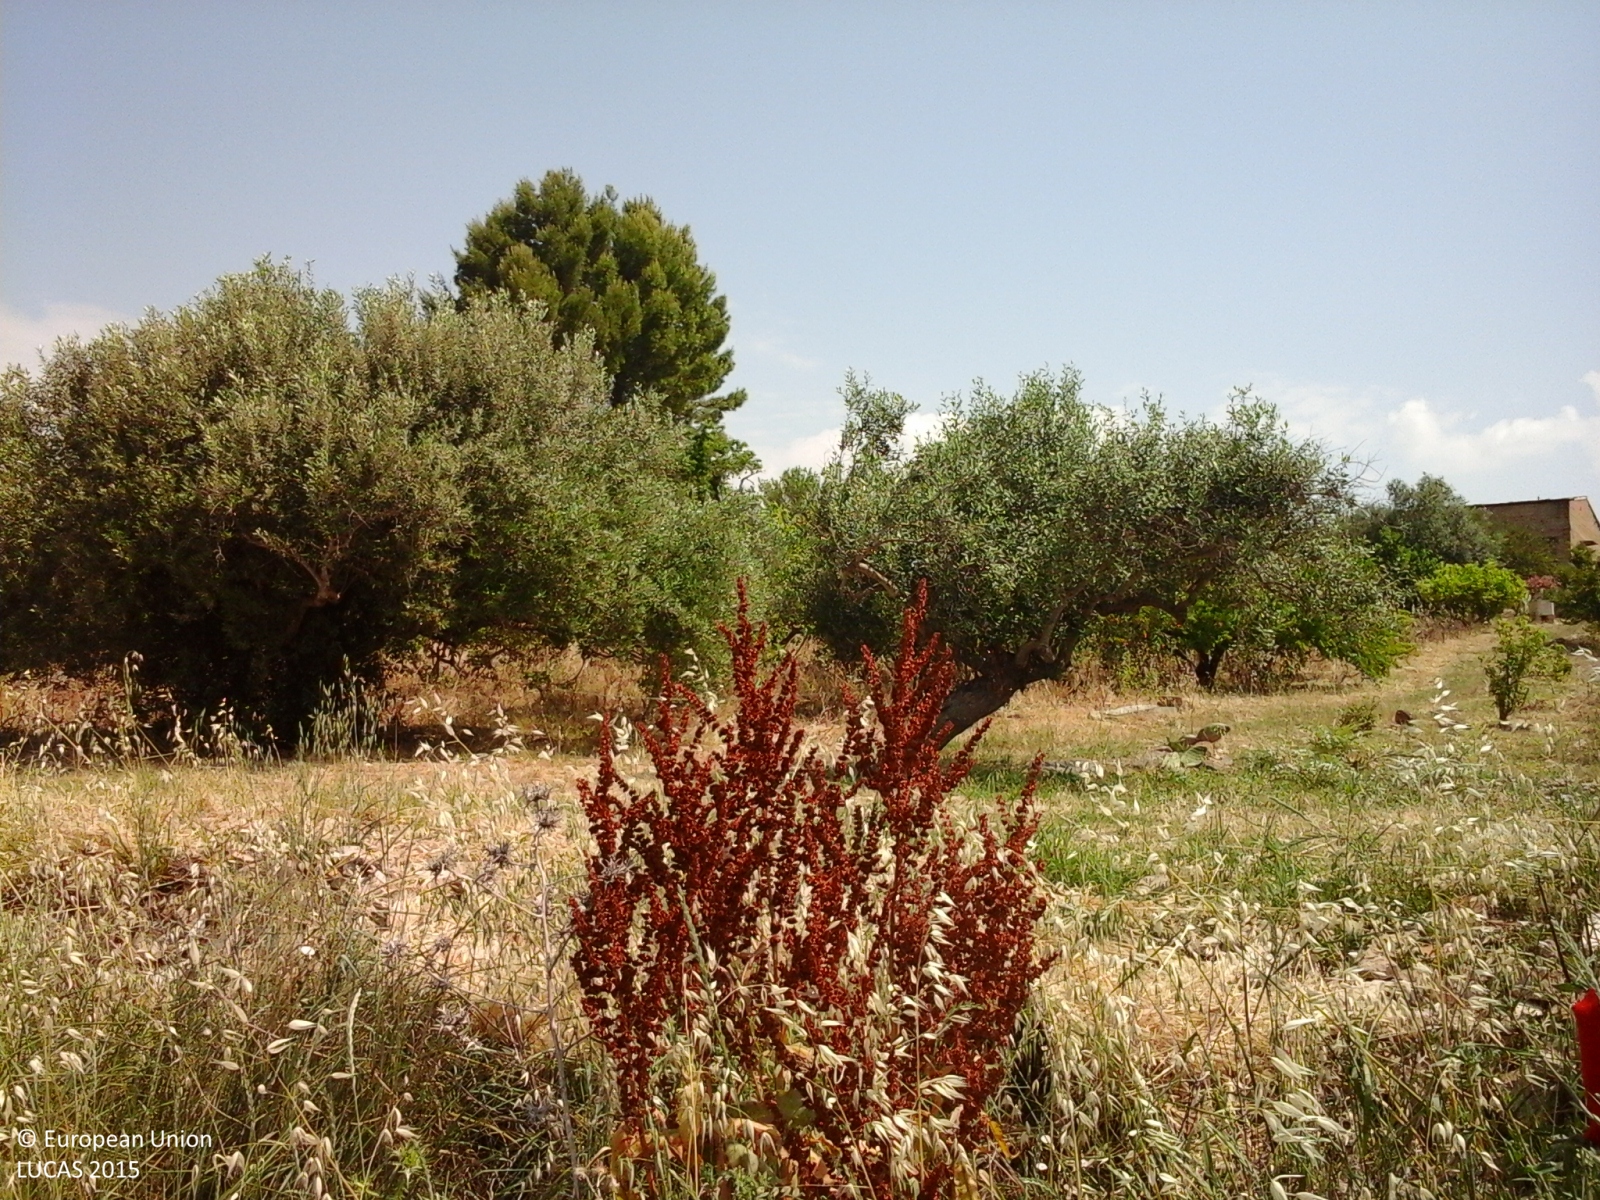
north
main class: Grassland
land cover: Grassland without tree/shrub cover
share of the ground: > 75 %
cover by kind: herbaceous plants 100 %
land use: Semi-natural and natural areas not in use
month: June
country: IT
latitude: 37.3385
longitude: 13.4832
